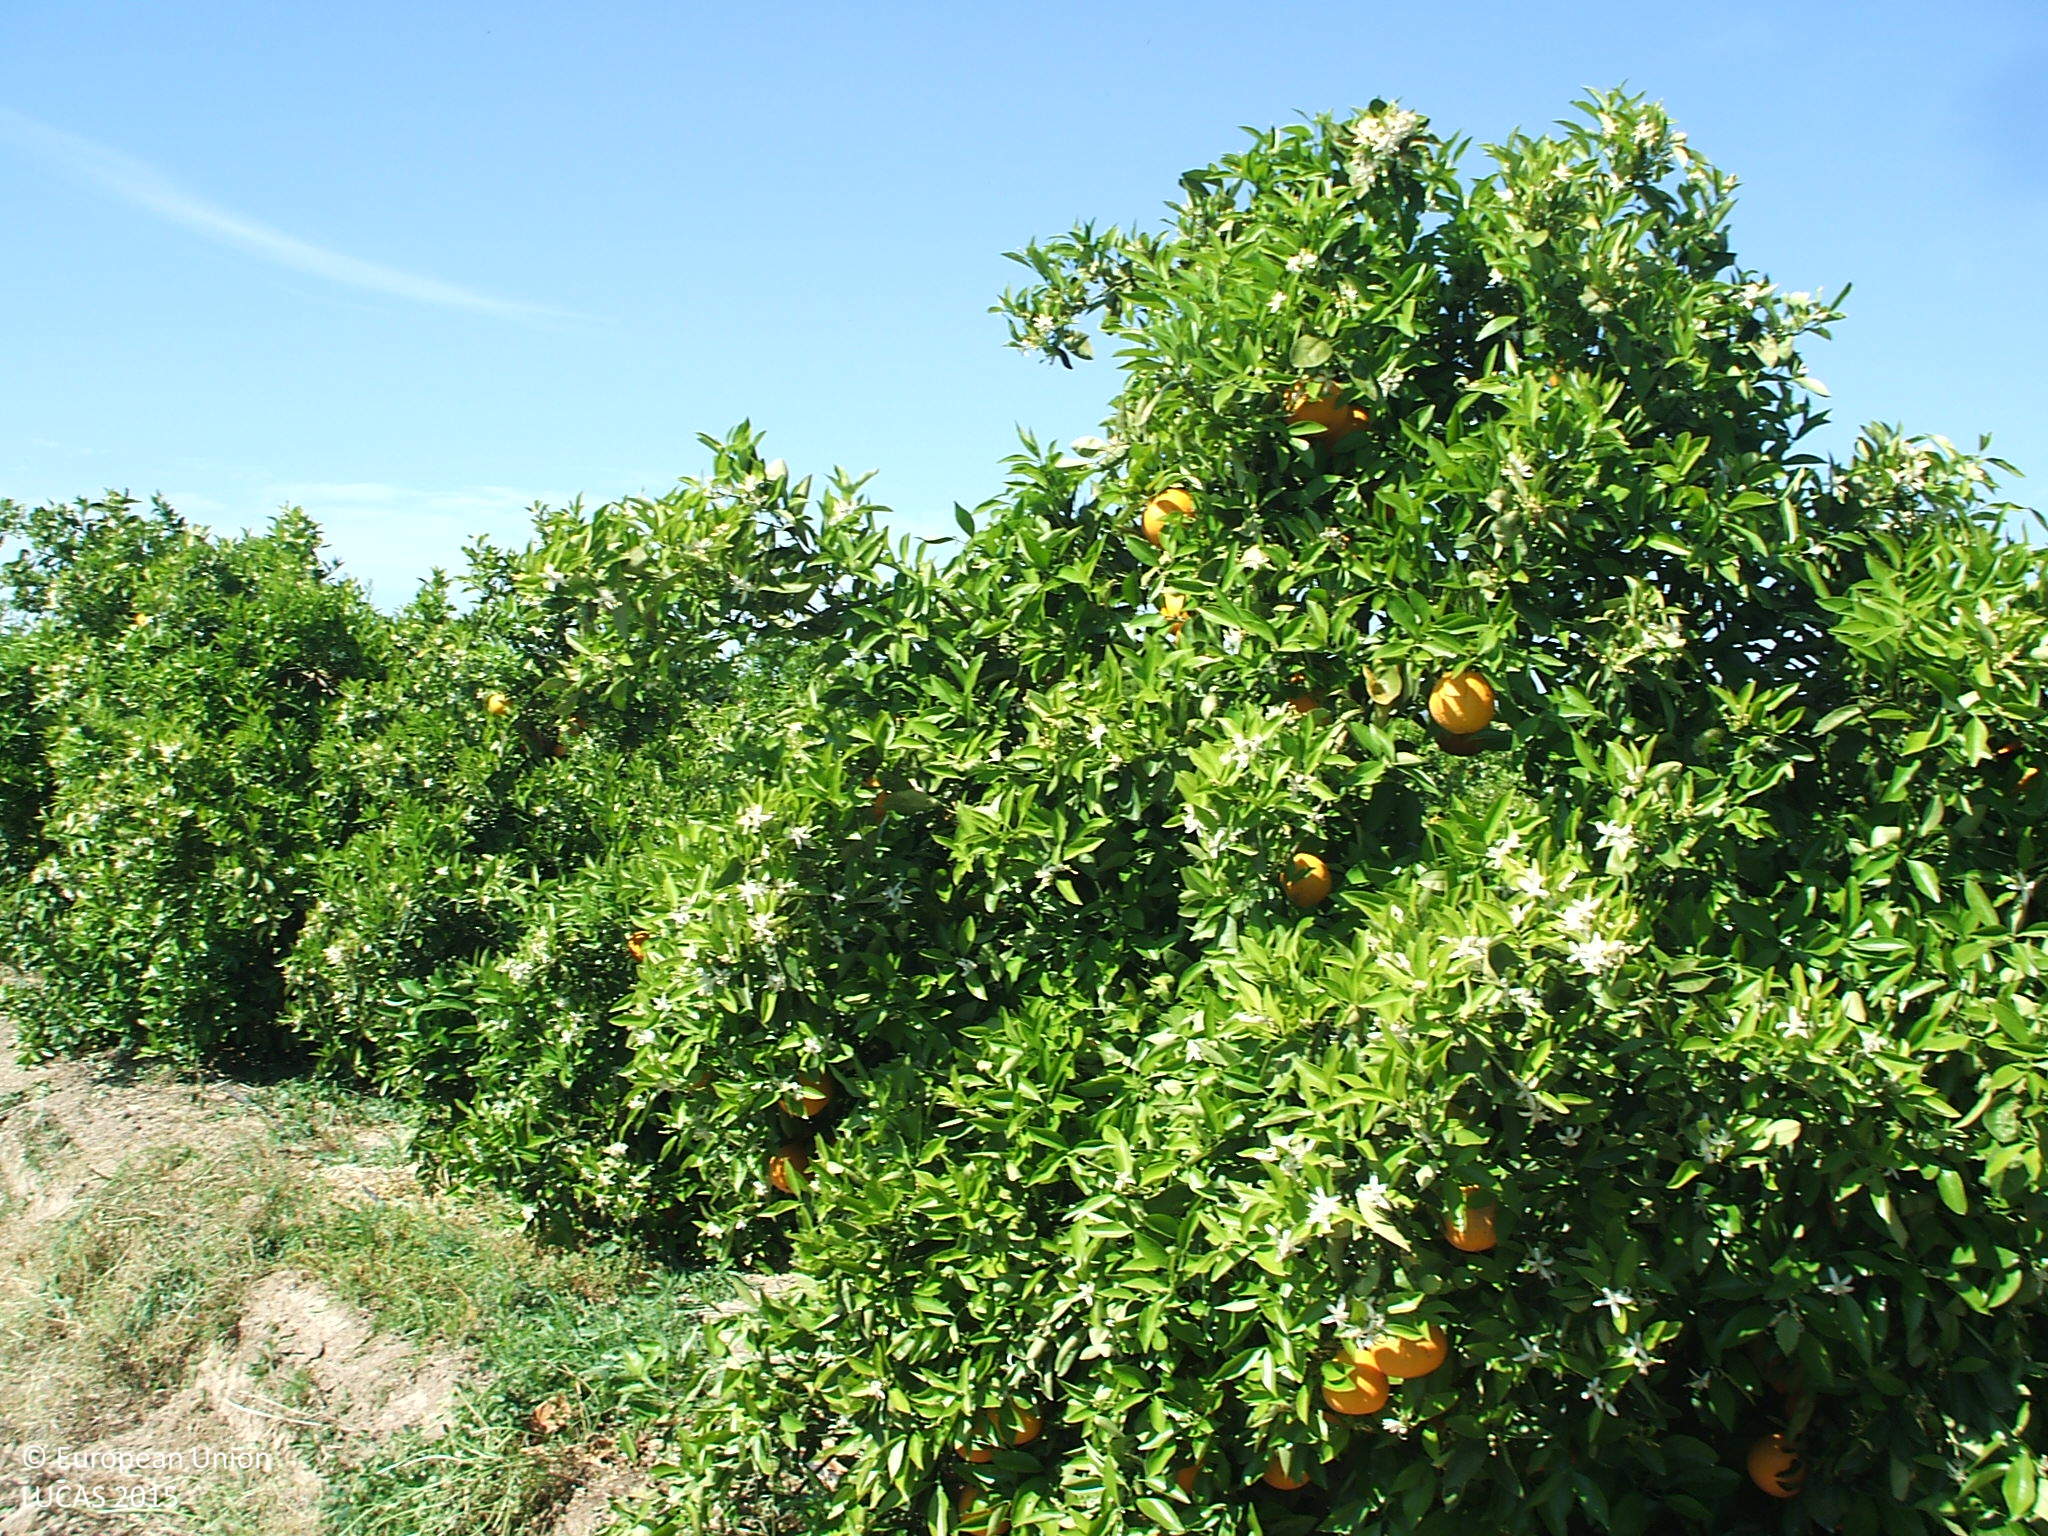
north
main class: Cropland
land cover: Oranges
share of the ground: 10 - 25 %
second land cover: Spontaneously vegetated surfaces
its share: 25 - 50 %
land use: Agriculture (excluding fallow land and kitchen gardens)
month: April
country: ES
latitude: 37.6558
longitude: -5.4471
